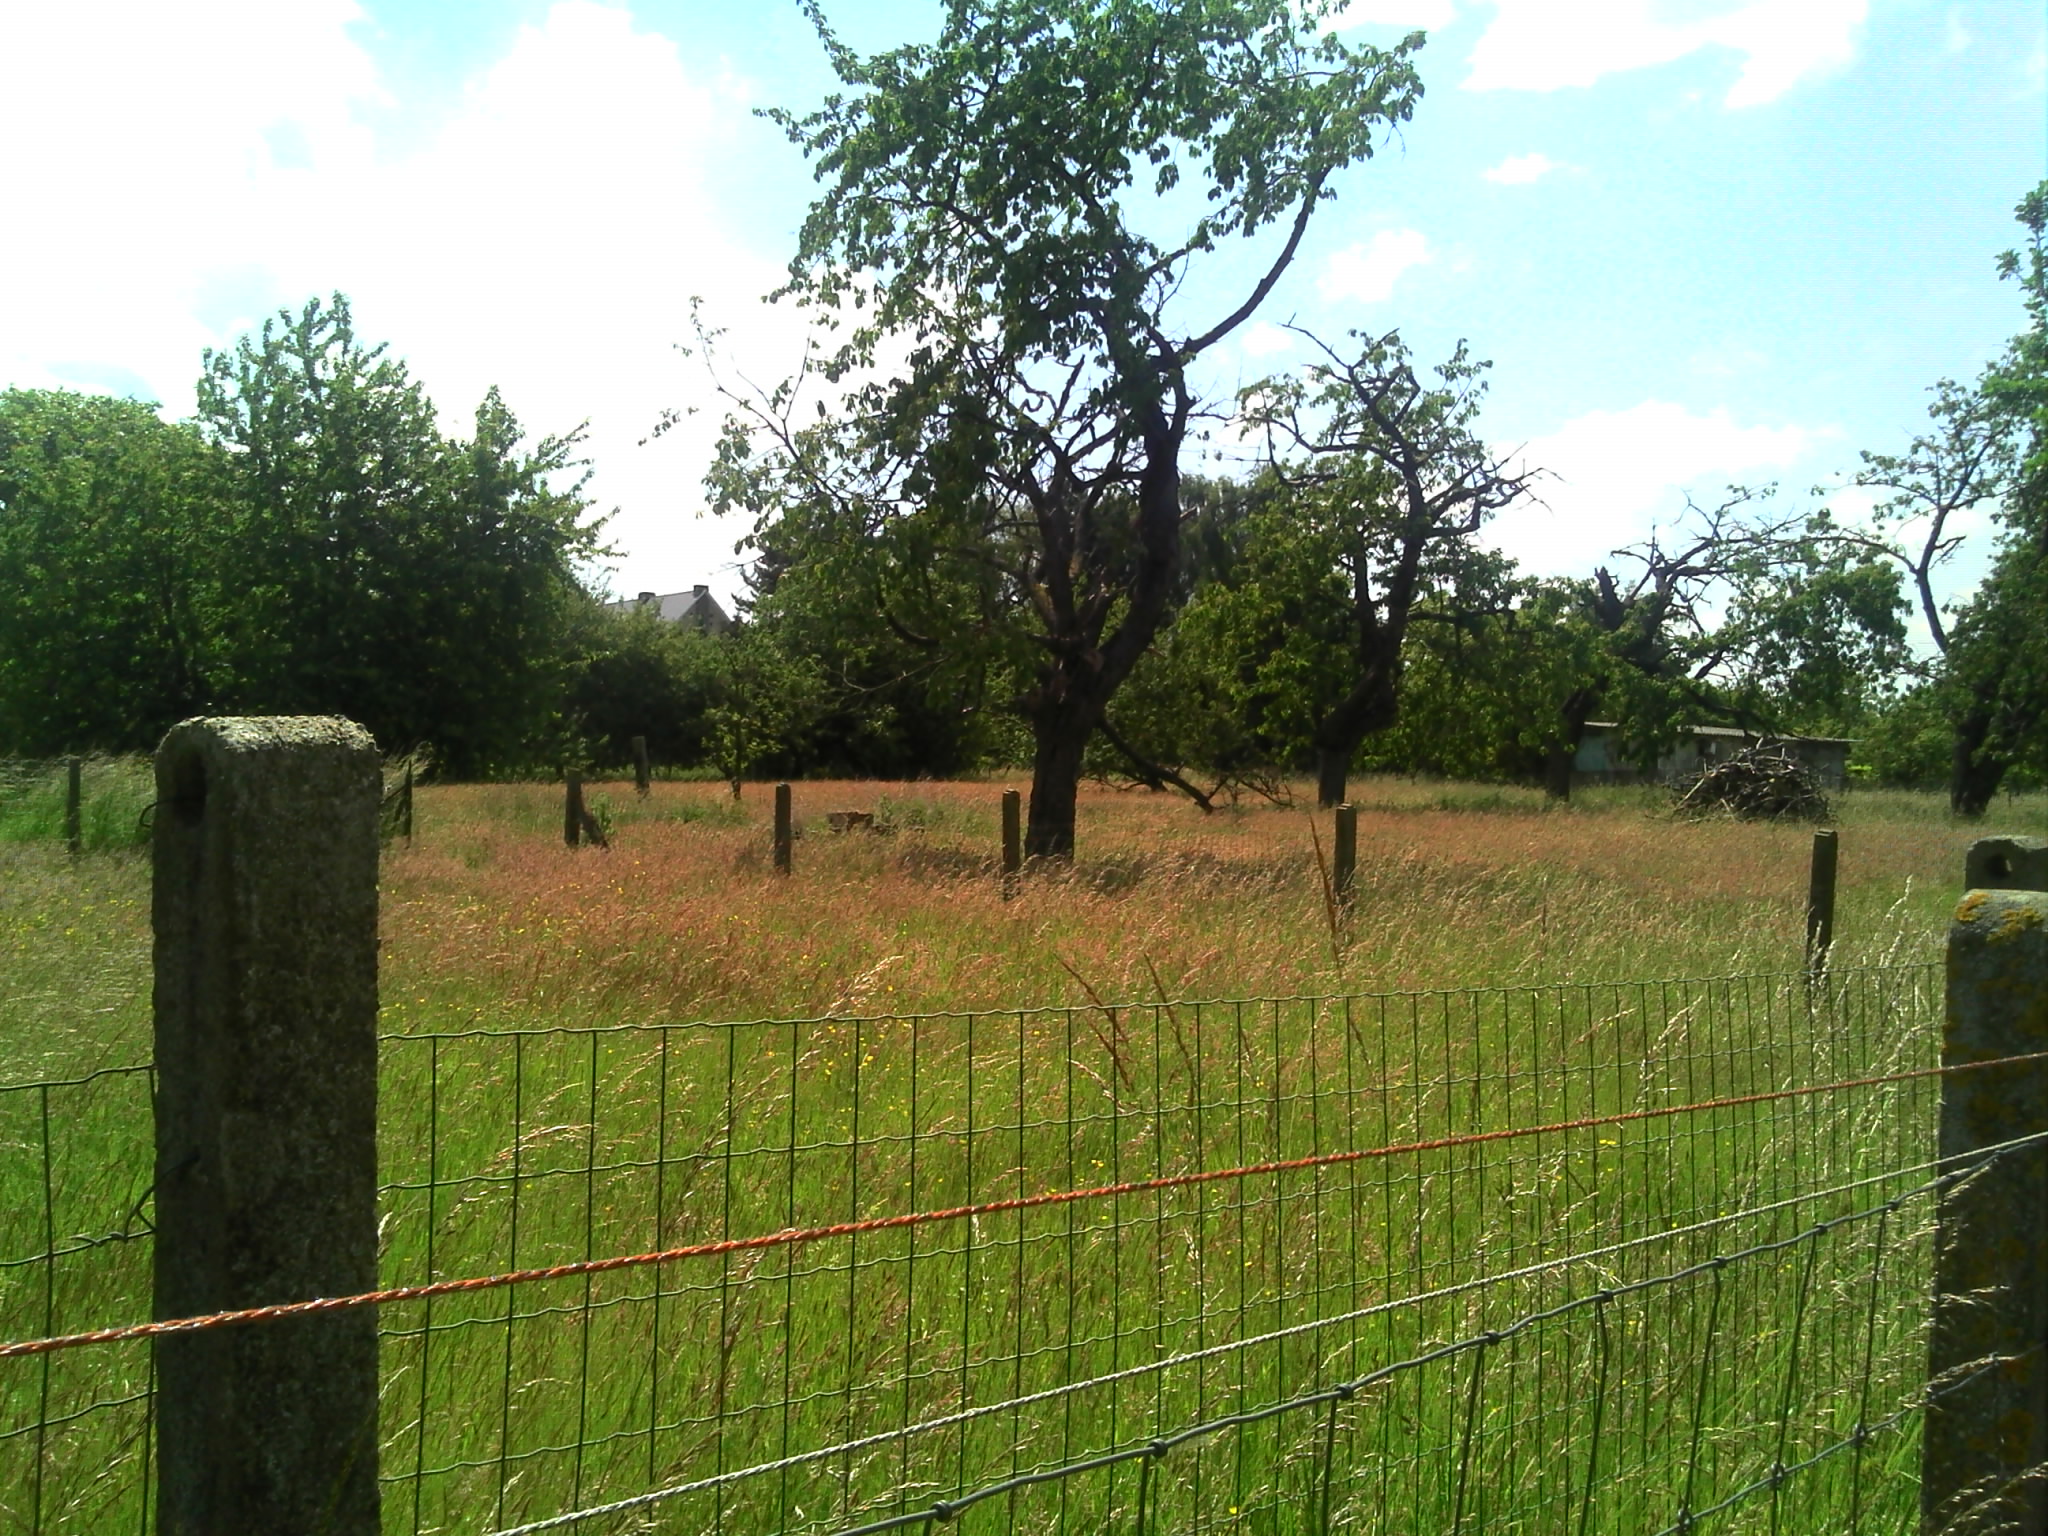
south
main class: Grassland
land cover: Grassland without tree/shrub cover
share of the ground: > 75 %
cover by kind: herbaceous plants 100 %
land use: Agriculture (excluding fallow land and kitchen gardens)
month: June
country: BE
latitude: 50.9438
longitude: 4.3164
